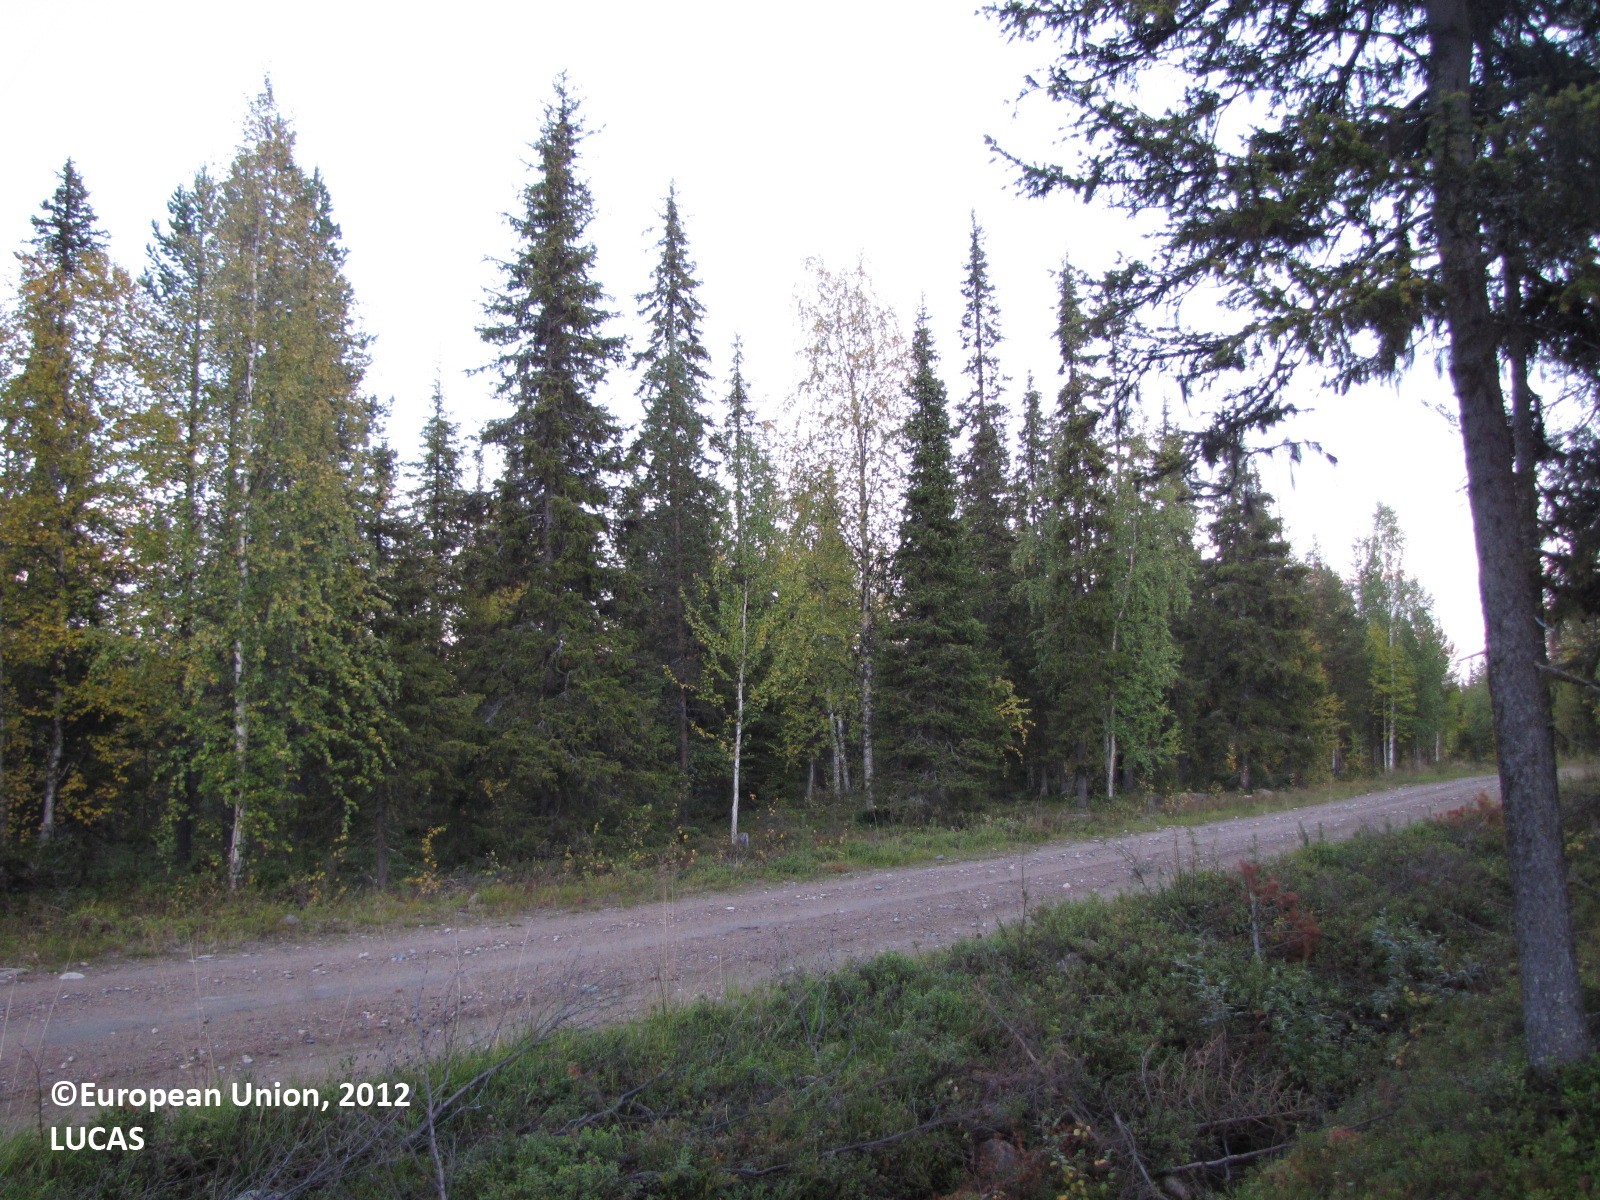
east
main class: Woodland
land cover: Spruce dominated coniferous woodland
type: boreal forest
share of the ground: 25 - 50 %
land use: Forestry
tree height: > 5 m
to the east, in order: Spruce dominated coniferous woodland; Ditches and canals; Shruby margins; Tracks; Shruby margins; Ditches and canals; Spruce dominated mixed woodland; Pine dominated mixed woodland; Other coniferous woodland
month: September
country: FI
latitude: 67.3665
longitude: 25.3467
